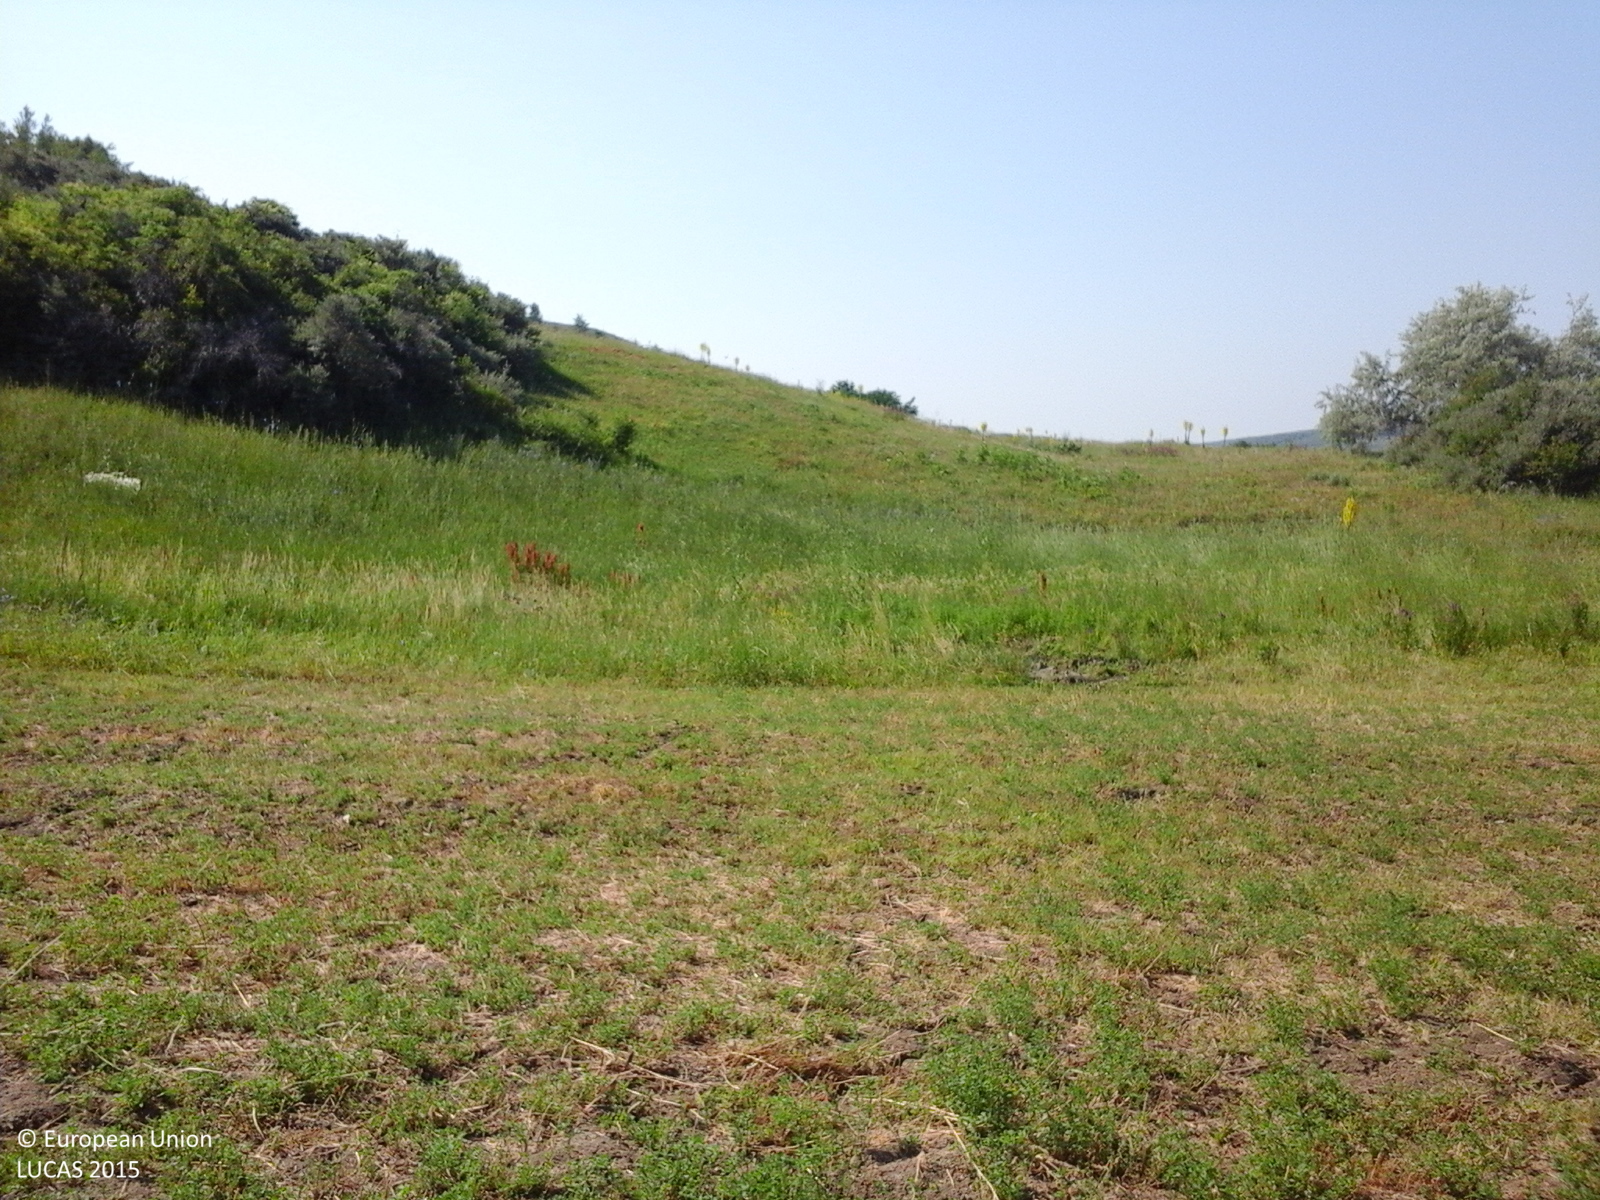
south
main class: Cropland
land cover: Lucerne
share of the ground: < 10 %
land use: Agriculture (excluding fallow land and kitchen gardens)
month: June
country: RO
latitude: 46.9792
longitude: 27.8055
